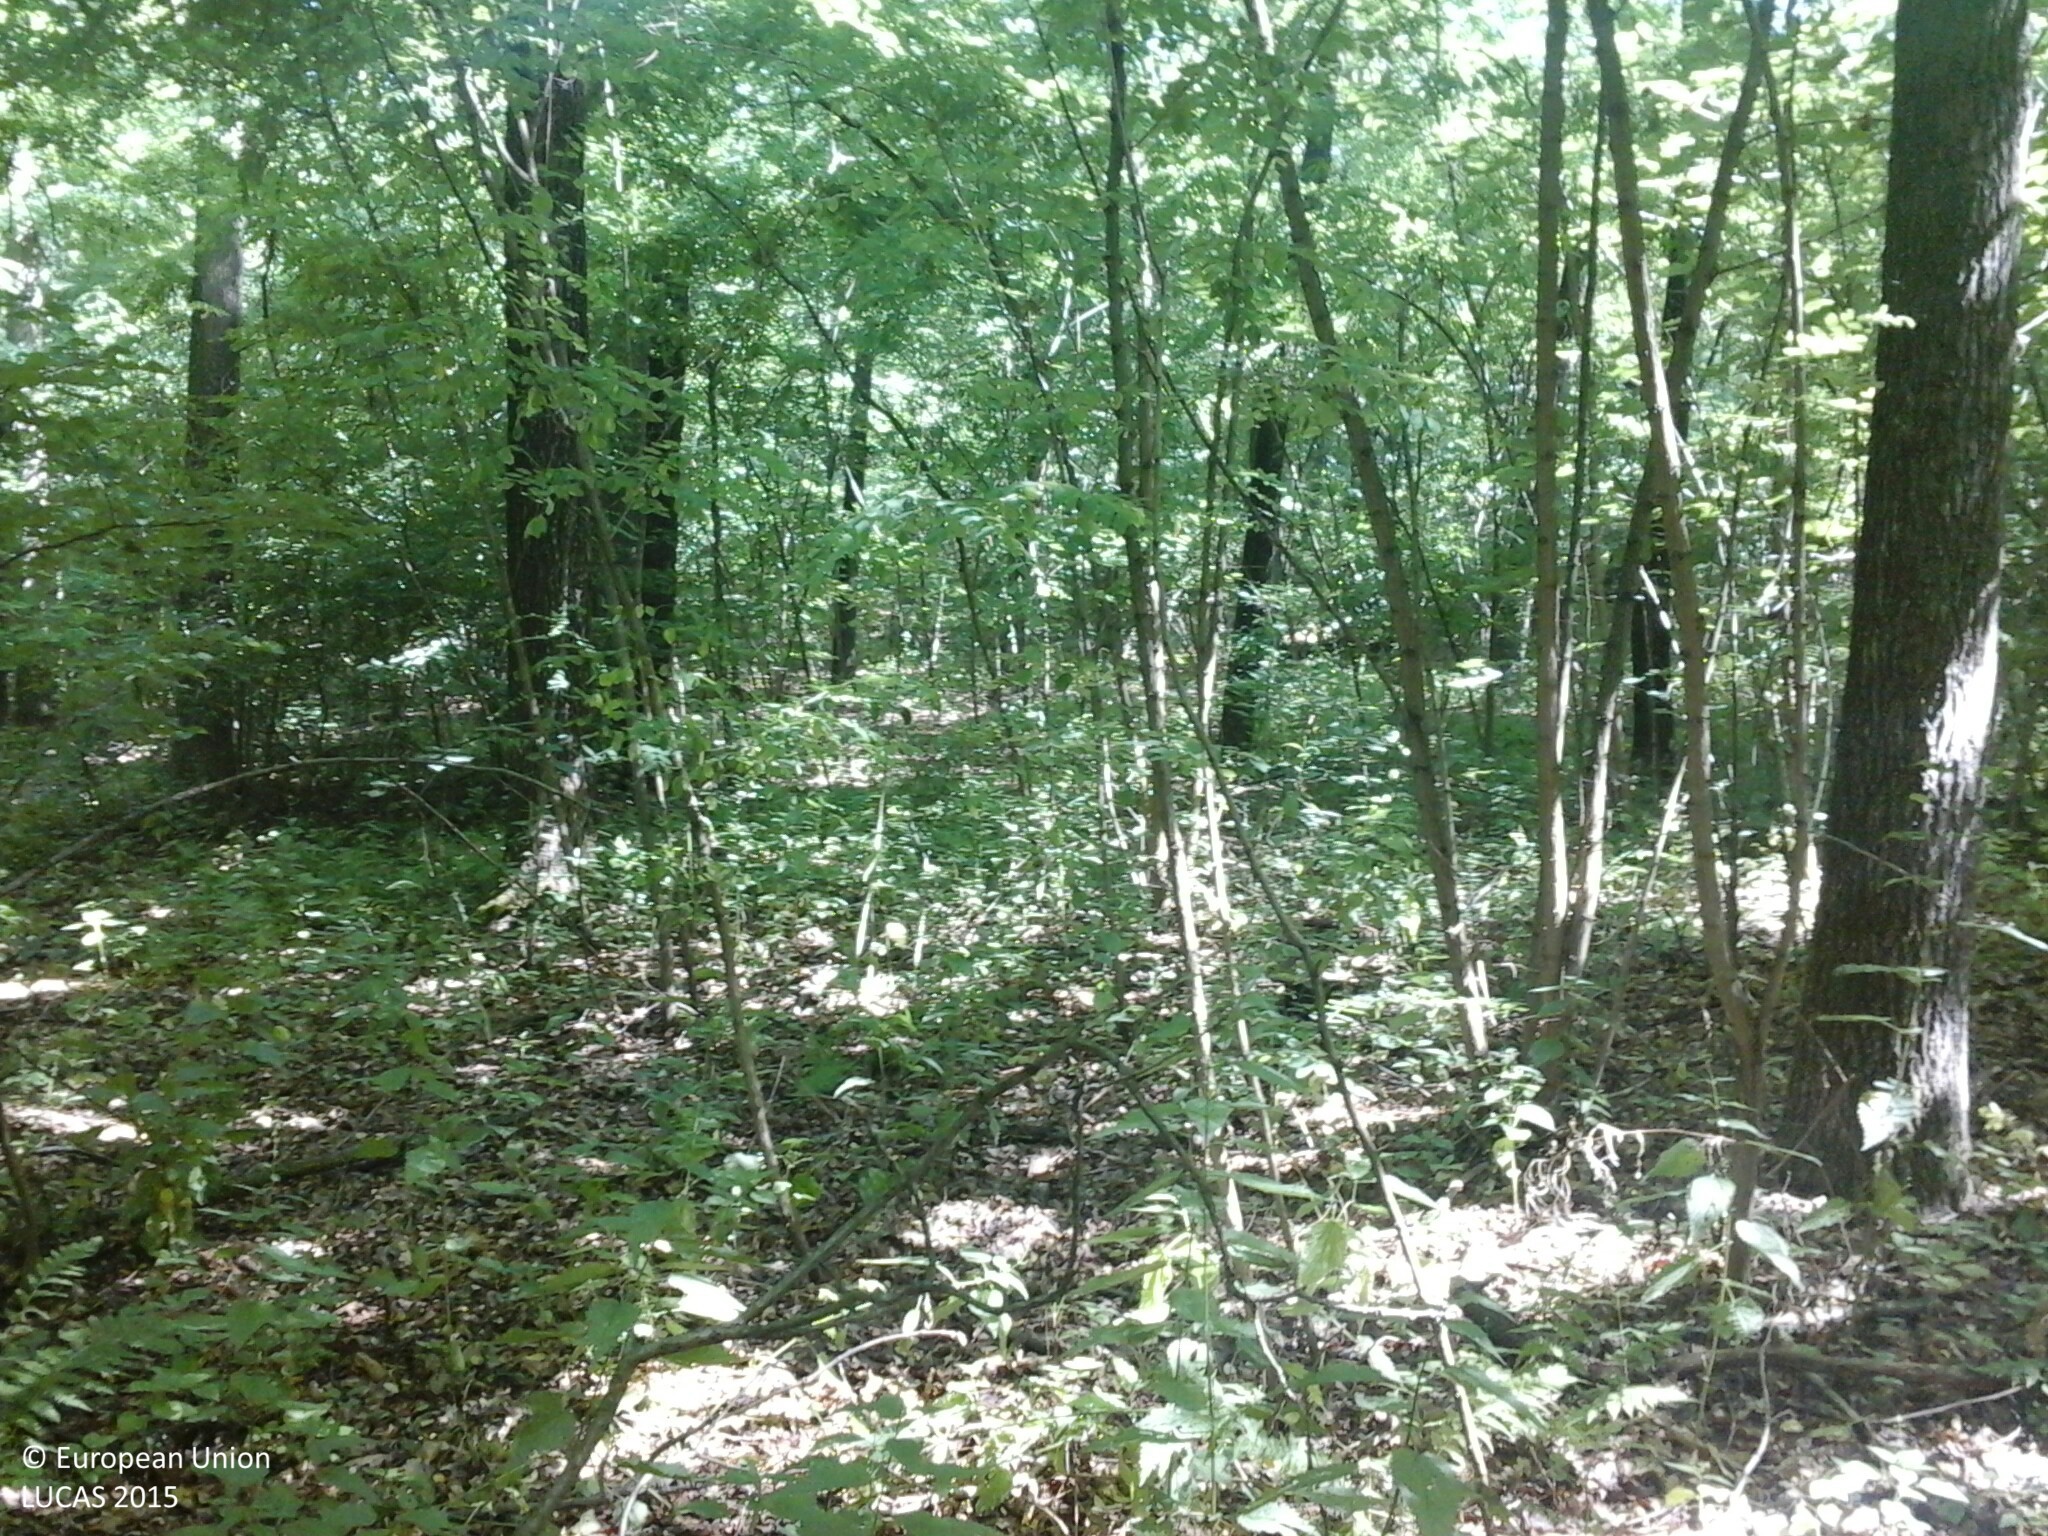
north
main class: Woodland
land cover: Broadleaved woodland
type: mesophytic deciduous forest
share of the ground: > 75 %
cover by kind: broadleaved forest trees 90 %, herbaceous plants 10 %
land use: Forestry
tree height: > 5 m
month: July
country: HU
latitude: 48.0616
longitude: 22.2808
